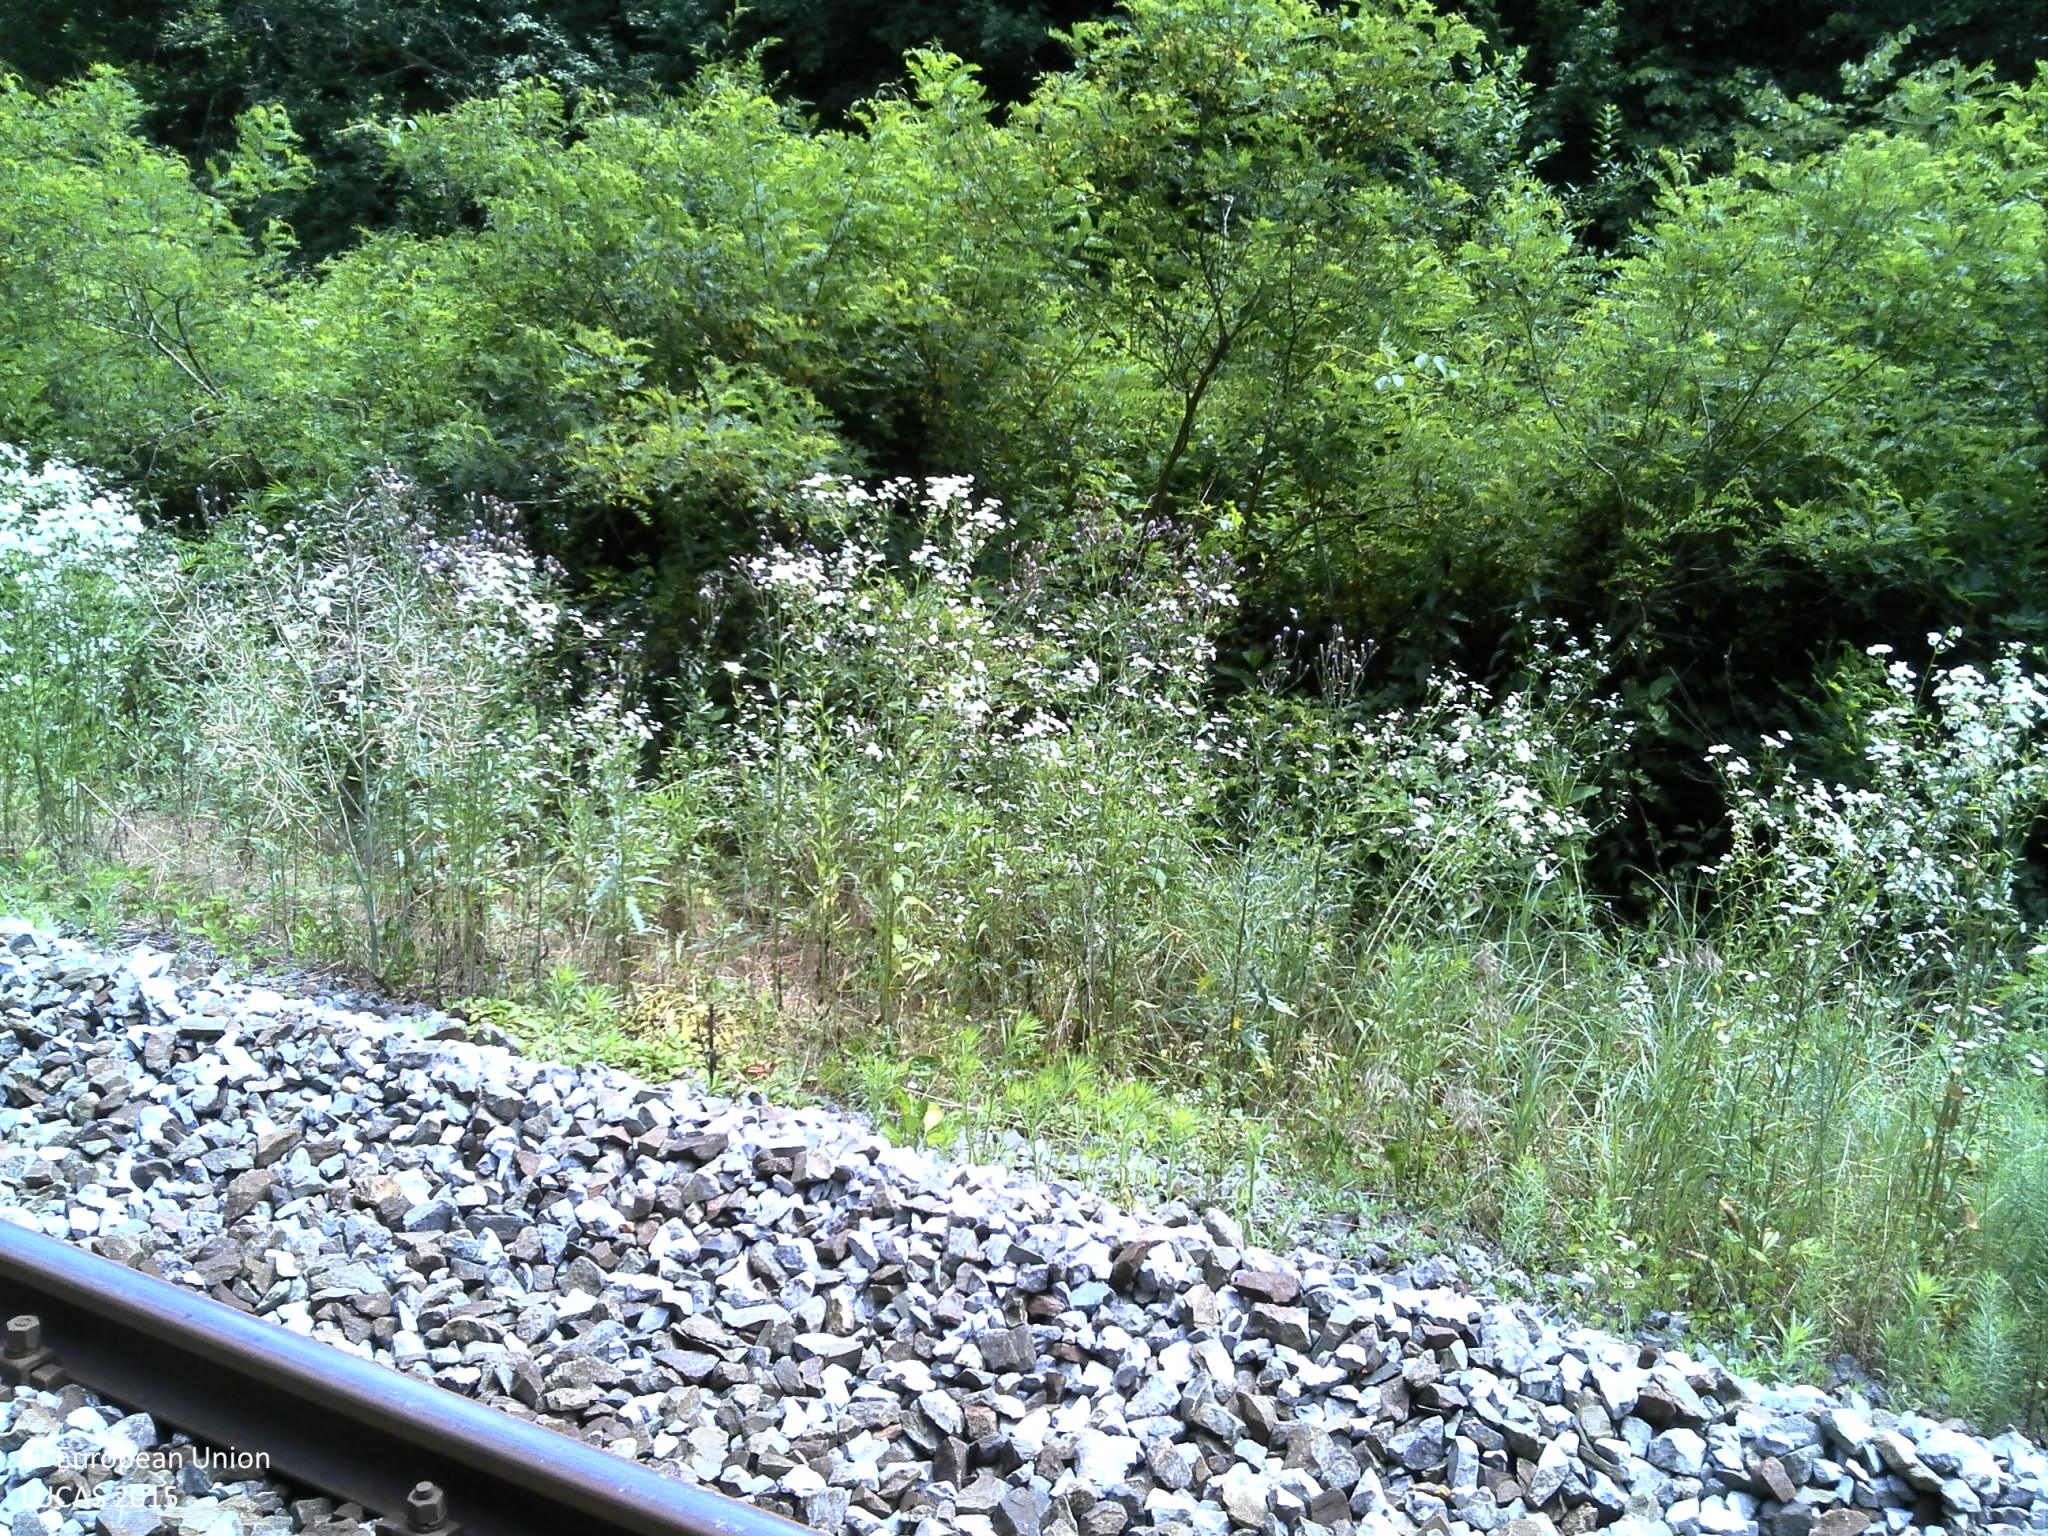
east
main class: Woodland
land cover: Broadleaved woodland
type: mesophytic deciduous forest
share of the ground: > 75 %
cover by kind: broadleaved forest trees 100 %
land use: Forestry
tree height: > 5 m
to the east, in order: Broadleaved woodland; Shrubland without tree cover; Electric lines; Railways; Shrubland with sparse tree cover; Ditches and canals; Tracks; Ditches and canals; Broadleaved woodland
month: June
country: HR
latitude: 44.9317
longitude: 18.8628
